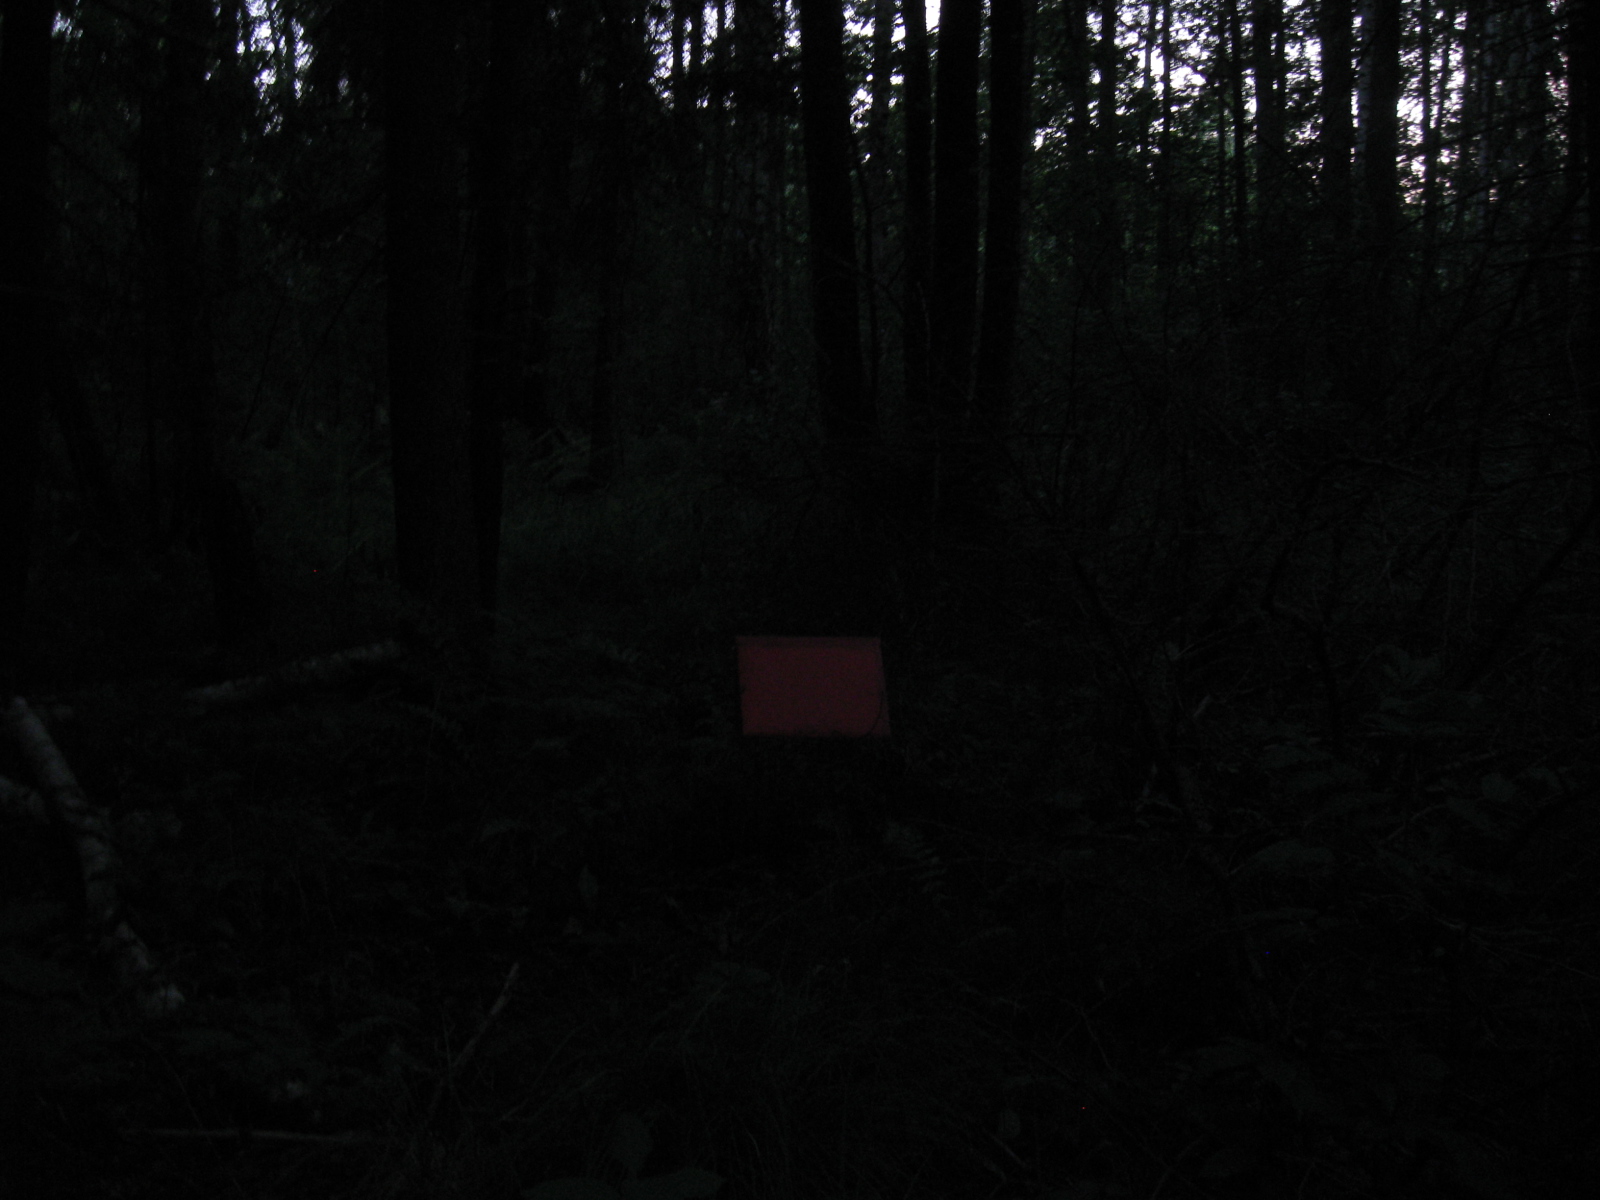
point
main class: Woodland
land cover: Other mixed woodland
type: hemiboreal forest and nemoral coniferous forest and mixed broadleaved-coniferous forest
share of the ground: > 75 %
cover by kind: broadleaved forest trees 65 %, coniferous forest trees 30 %, herbaceous plants 5 %
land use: Forestry
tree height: > 5 m
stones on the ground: < 10 %
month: August
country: LT
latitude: 54.6312
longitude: 23.3231
